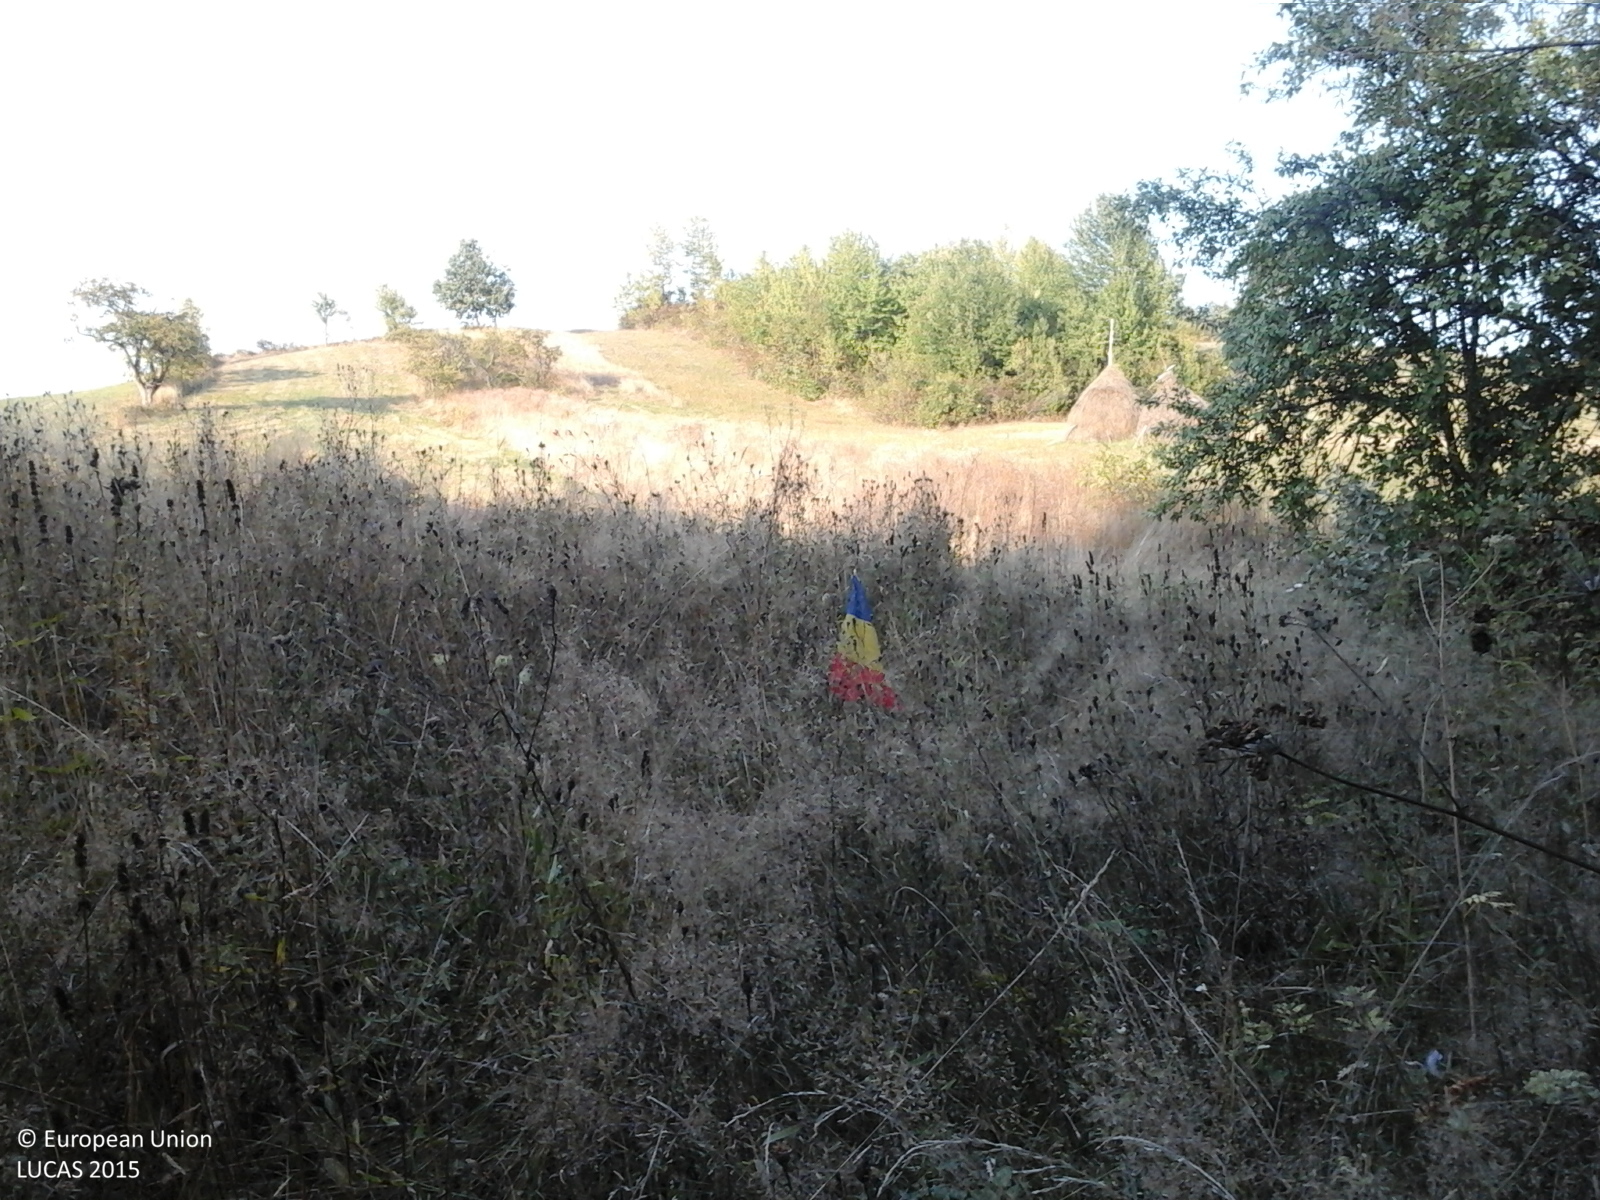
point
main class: Grassland
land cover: Grassland without tree/shrub cover
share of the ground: > 75 %
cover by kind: herbaceous plants 100 %
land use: Agriculture (excluding fallow land and kitchen gardens)
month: September
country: RO
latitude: 46.7322
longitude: 22.4444
